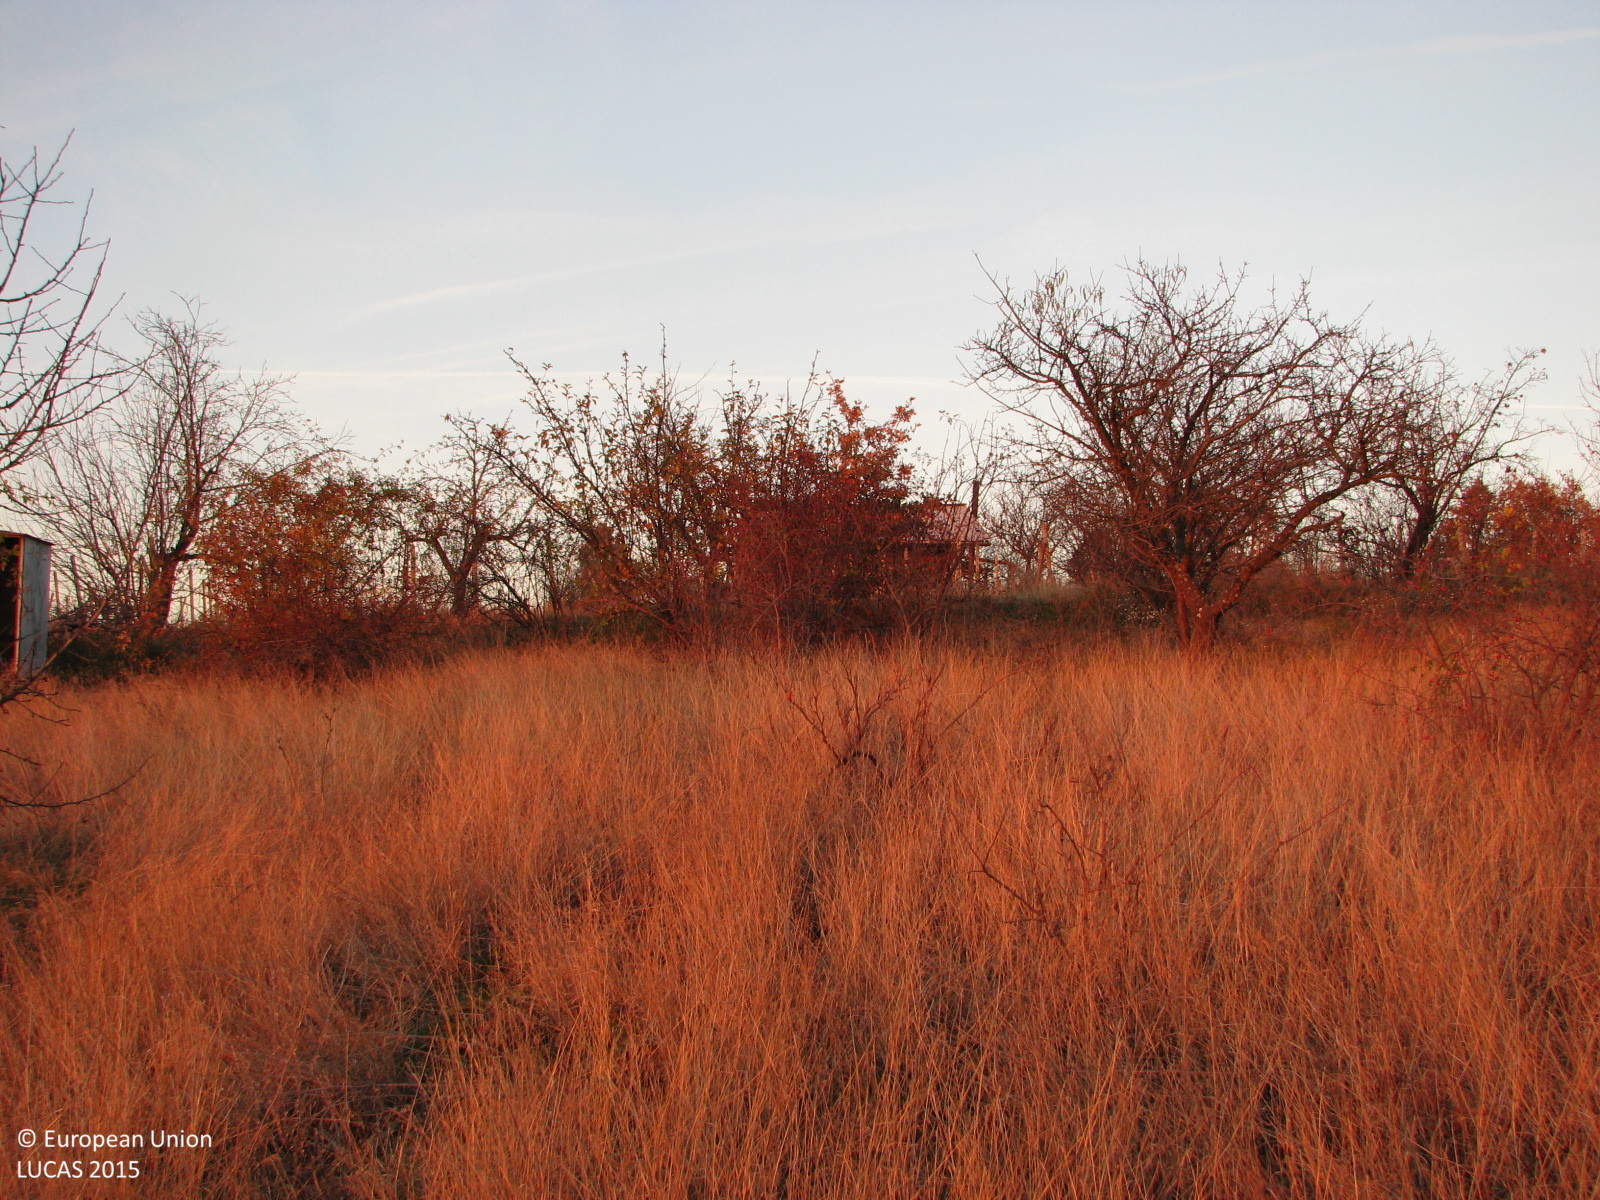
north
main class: Grassland
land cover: Grassland with sparse tree/shrub cover
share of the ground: > 75 %
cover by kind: herbaceous plants 90 %, broadleaved forest trees 5 %, shrubs 5 %
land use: Abandoned areas
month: December
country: BG
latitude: 42.4535
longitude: 24.8303
